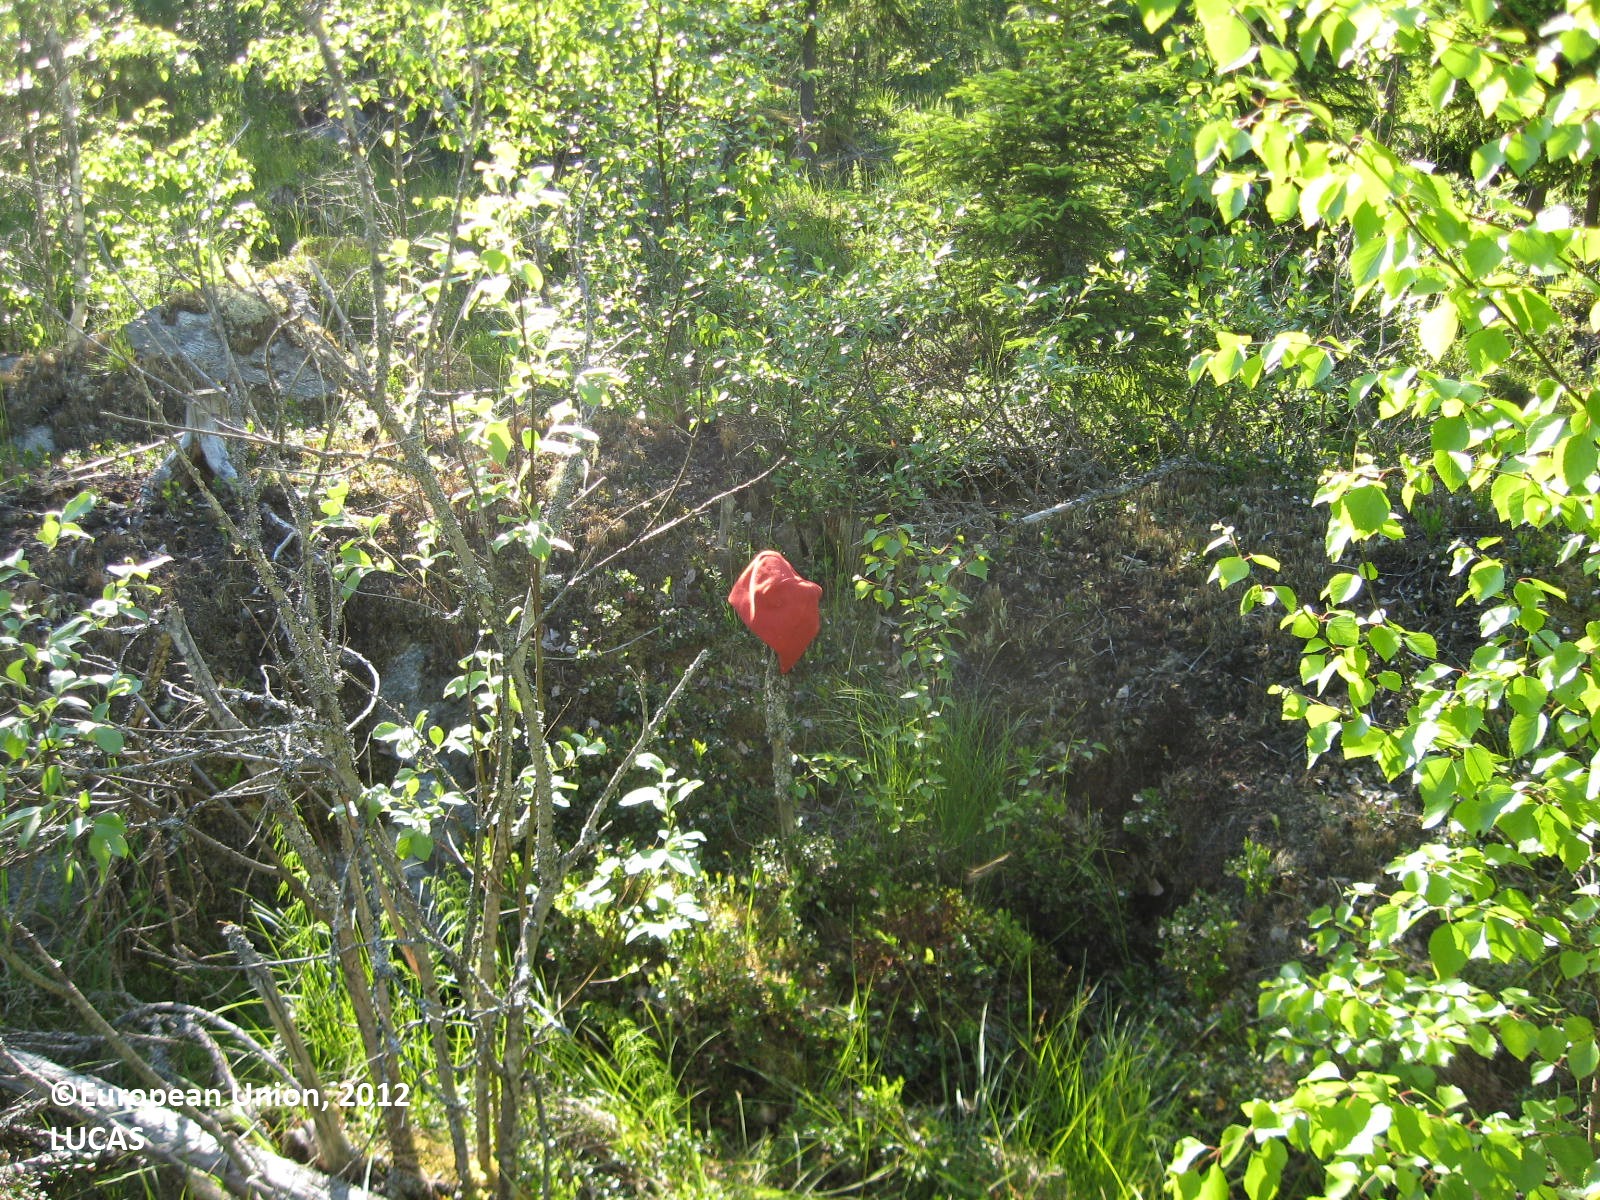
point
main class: Woodland
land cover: Broadleaved woodland
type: boreal forest
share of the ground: > 75 %
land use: Forestry
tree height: > 5 m
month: June
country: FI
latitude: 62.9438
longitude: 21.8875
